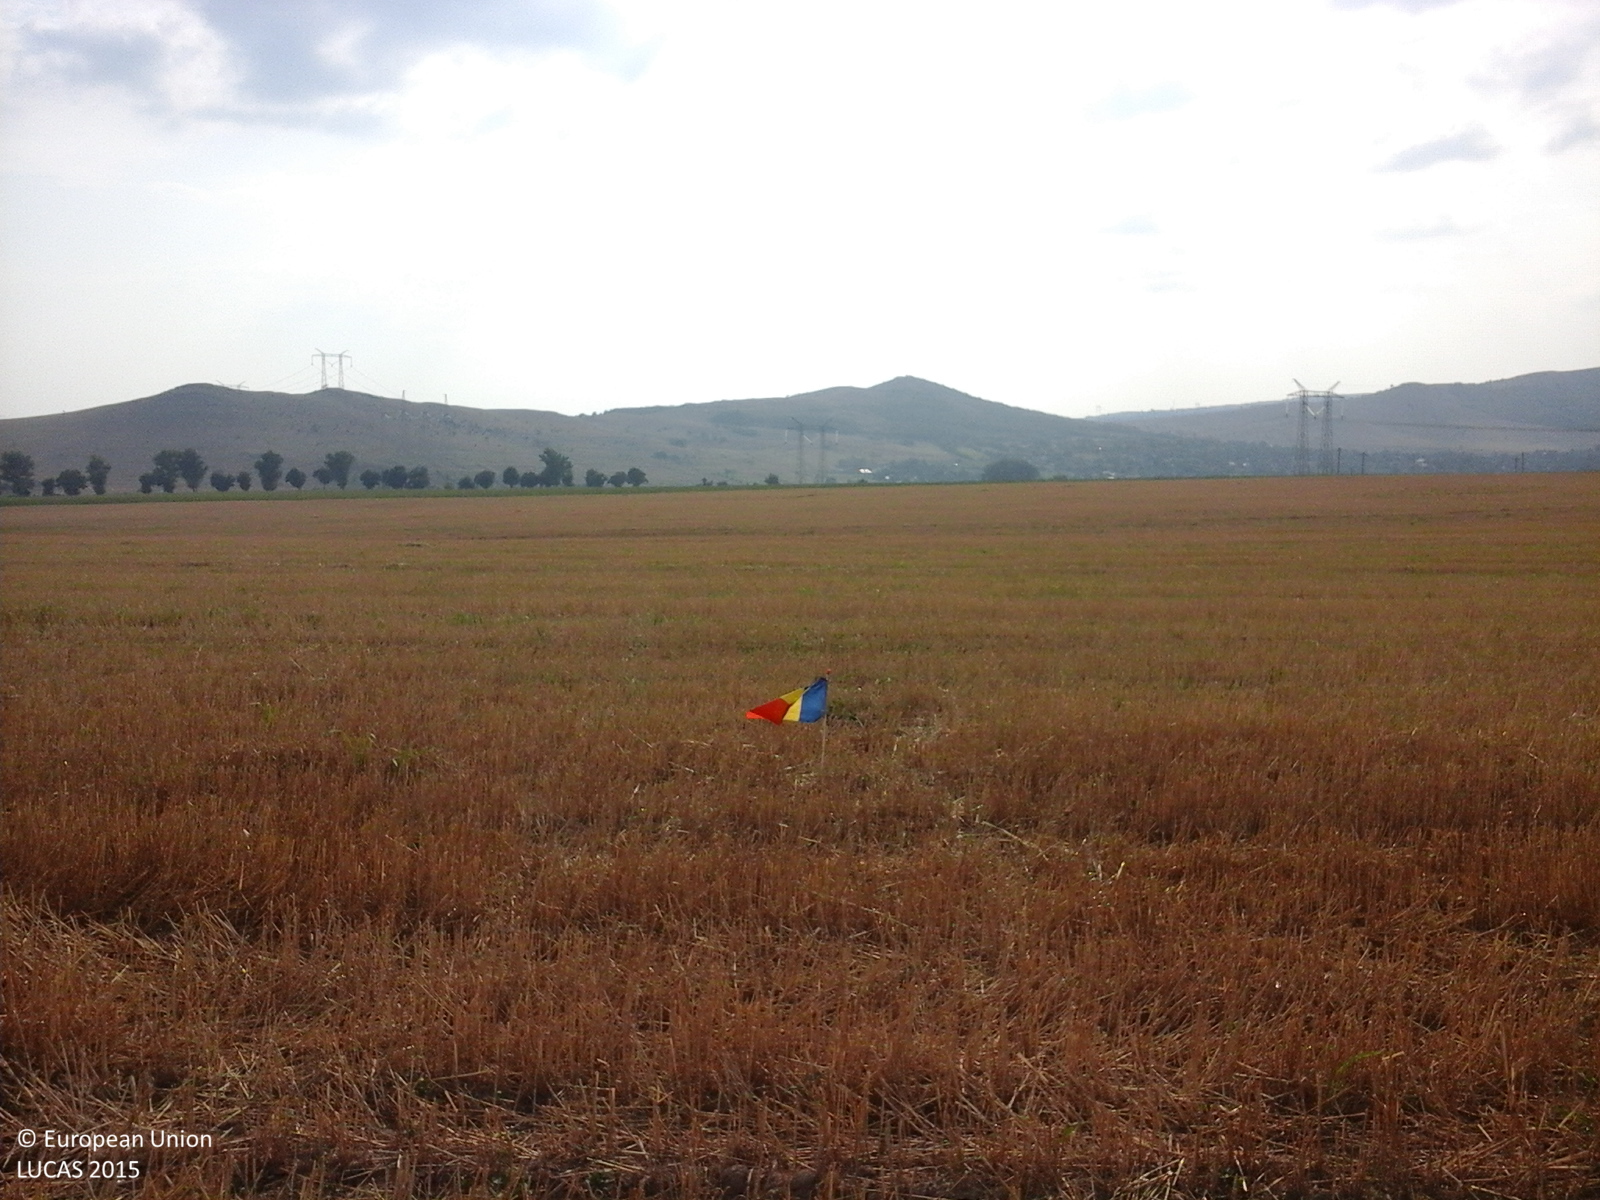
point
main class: Cropland
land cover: Common wheat
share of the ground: > 75 %
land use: Agriculture (excluding fallow land and kitchen gardens)
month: July
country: RO
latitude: 45.0642
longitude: 28.4279
